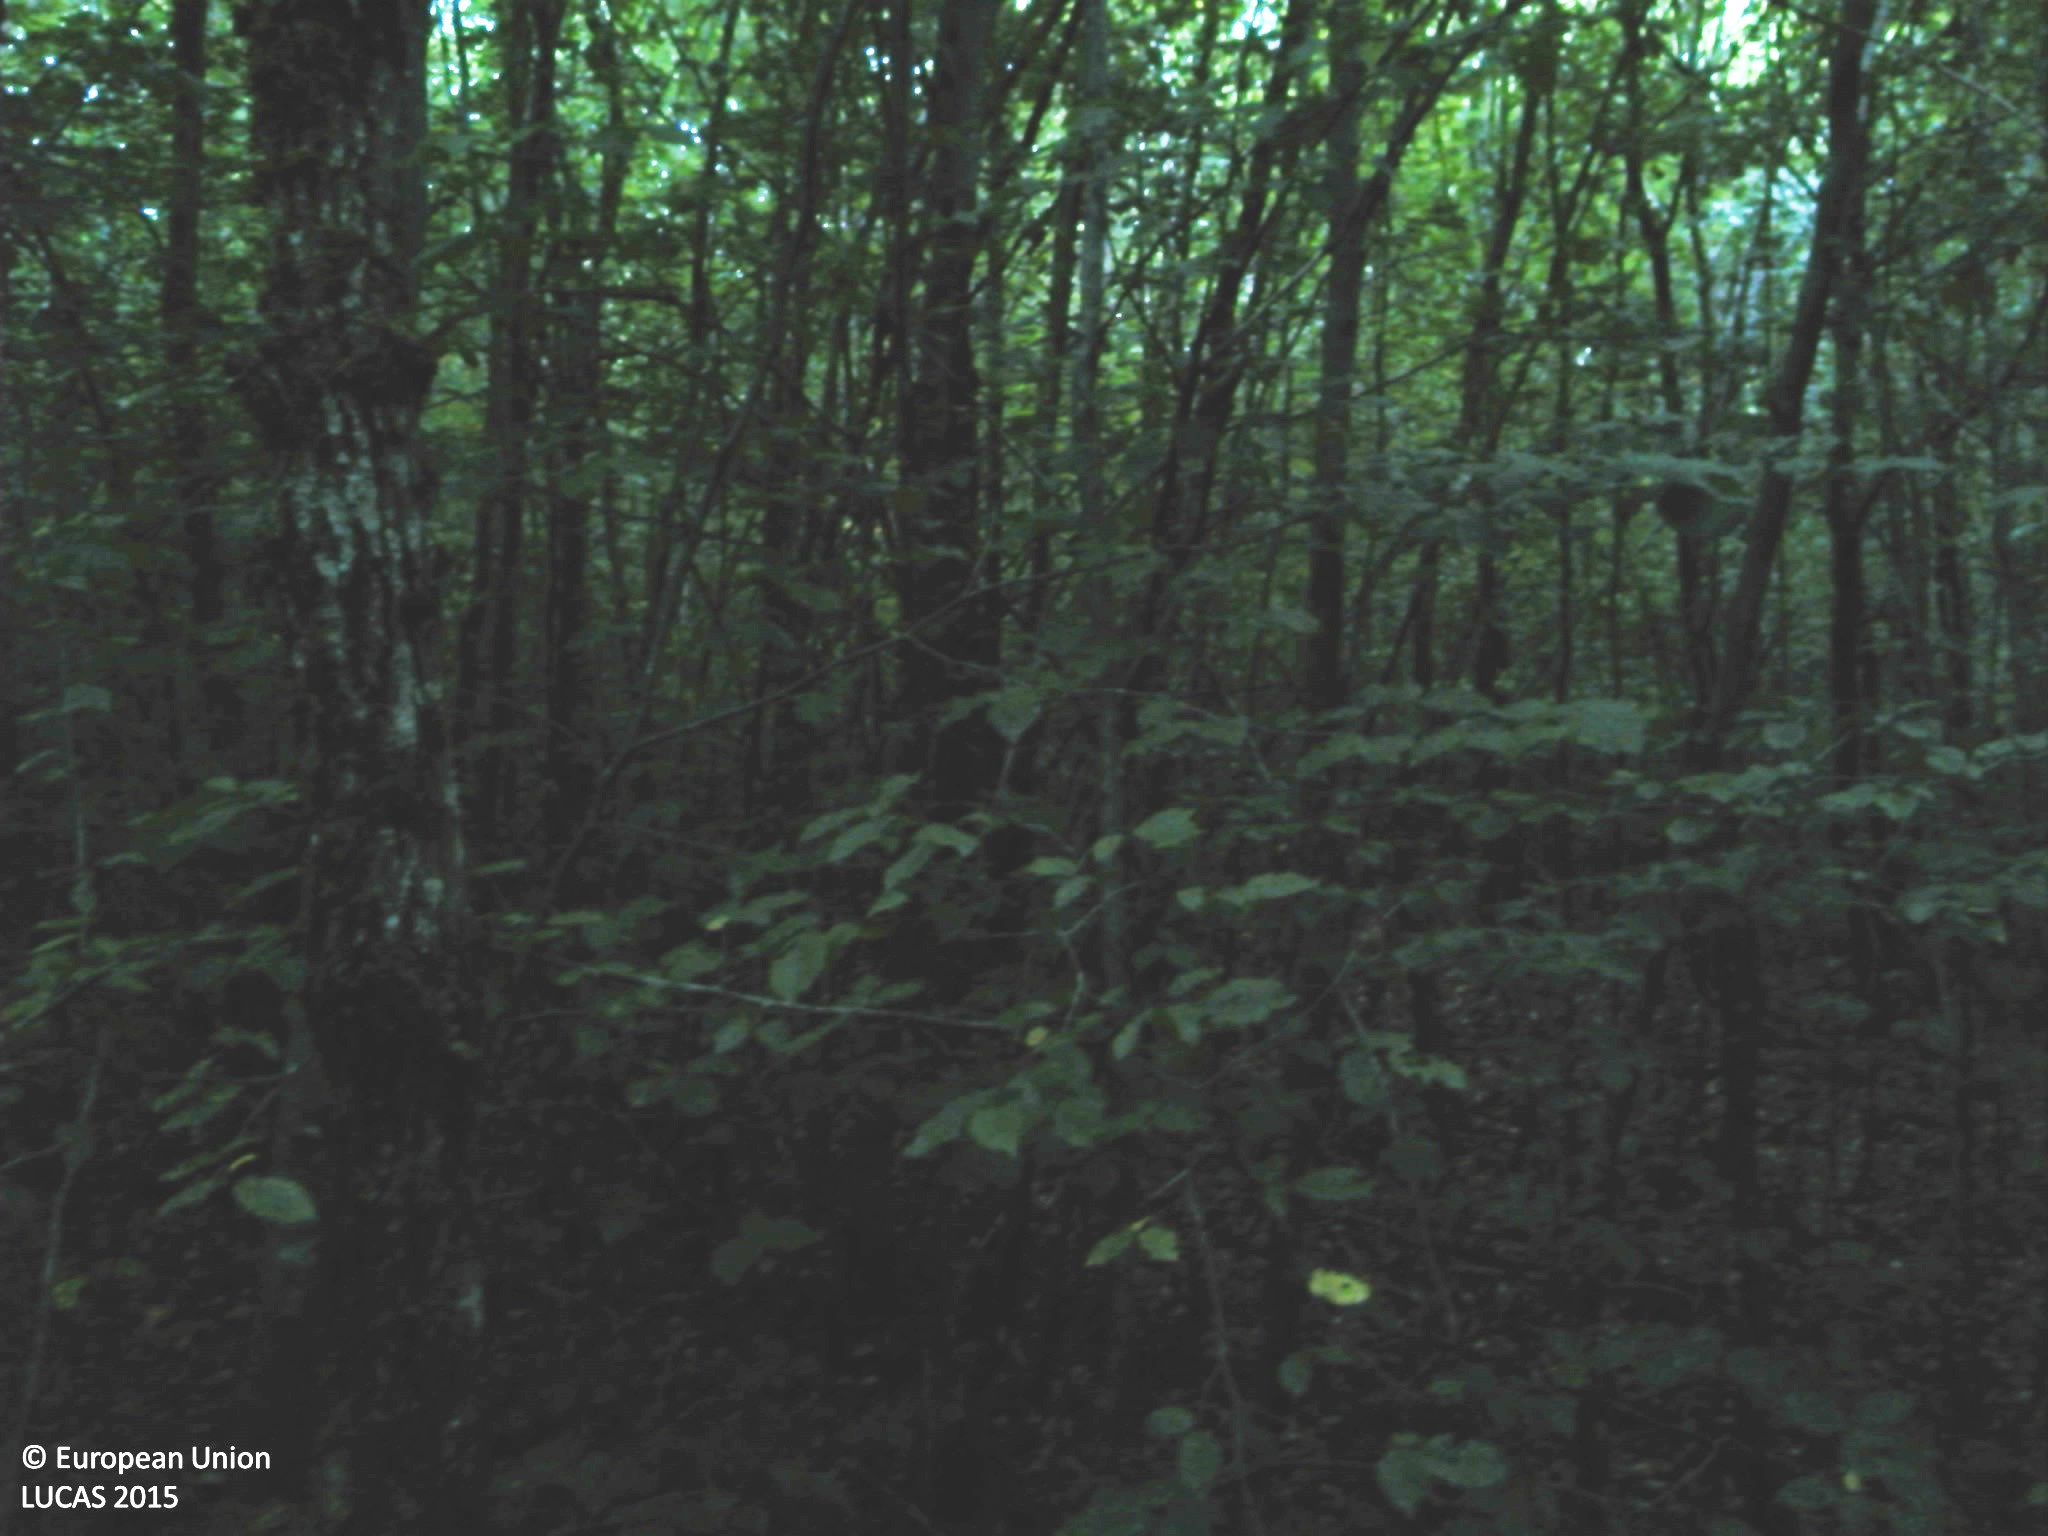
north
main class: Woodland
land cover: Broadleaved woodland
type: beech forest
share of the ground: > 75 %
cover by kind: broadleaved forest trees 90 %, unconsolidated bare surface 10 %
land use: Forestry
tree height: > 5 m
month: July
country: FR
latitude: 48.0643
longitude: 6.0956
